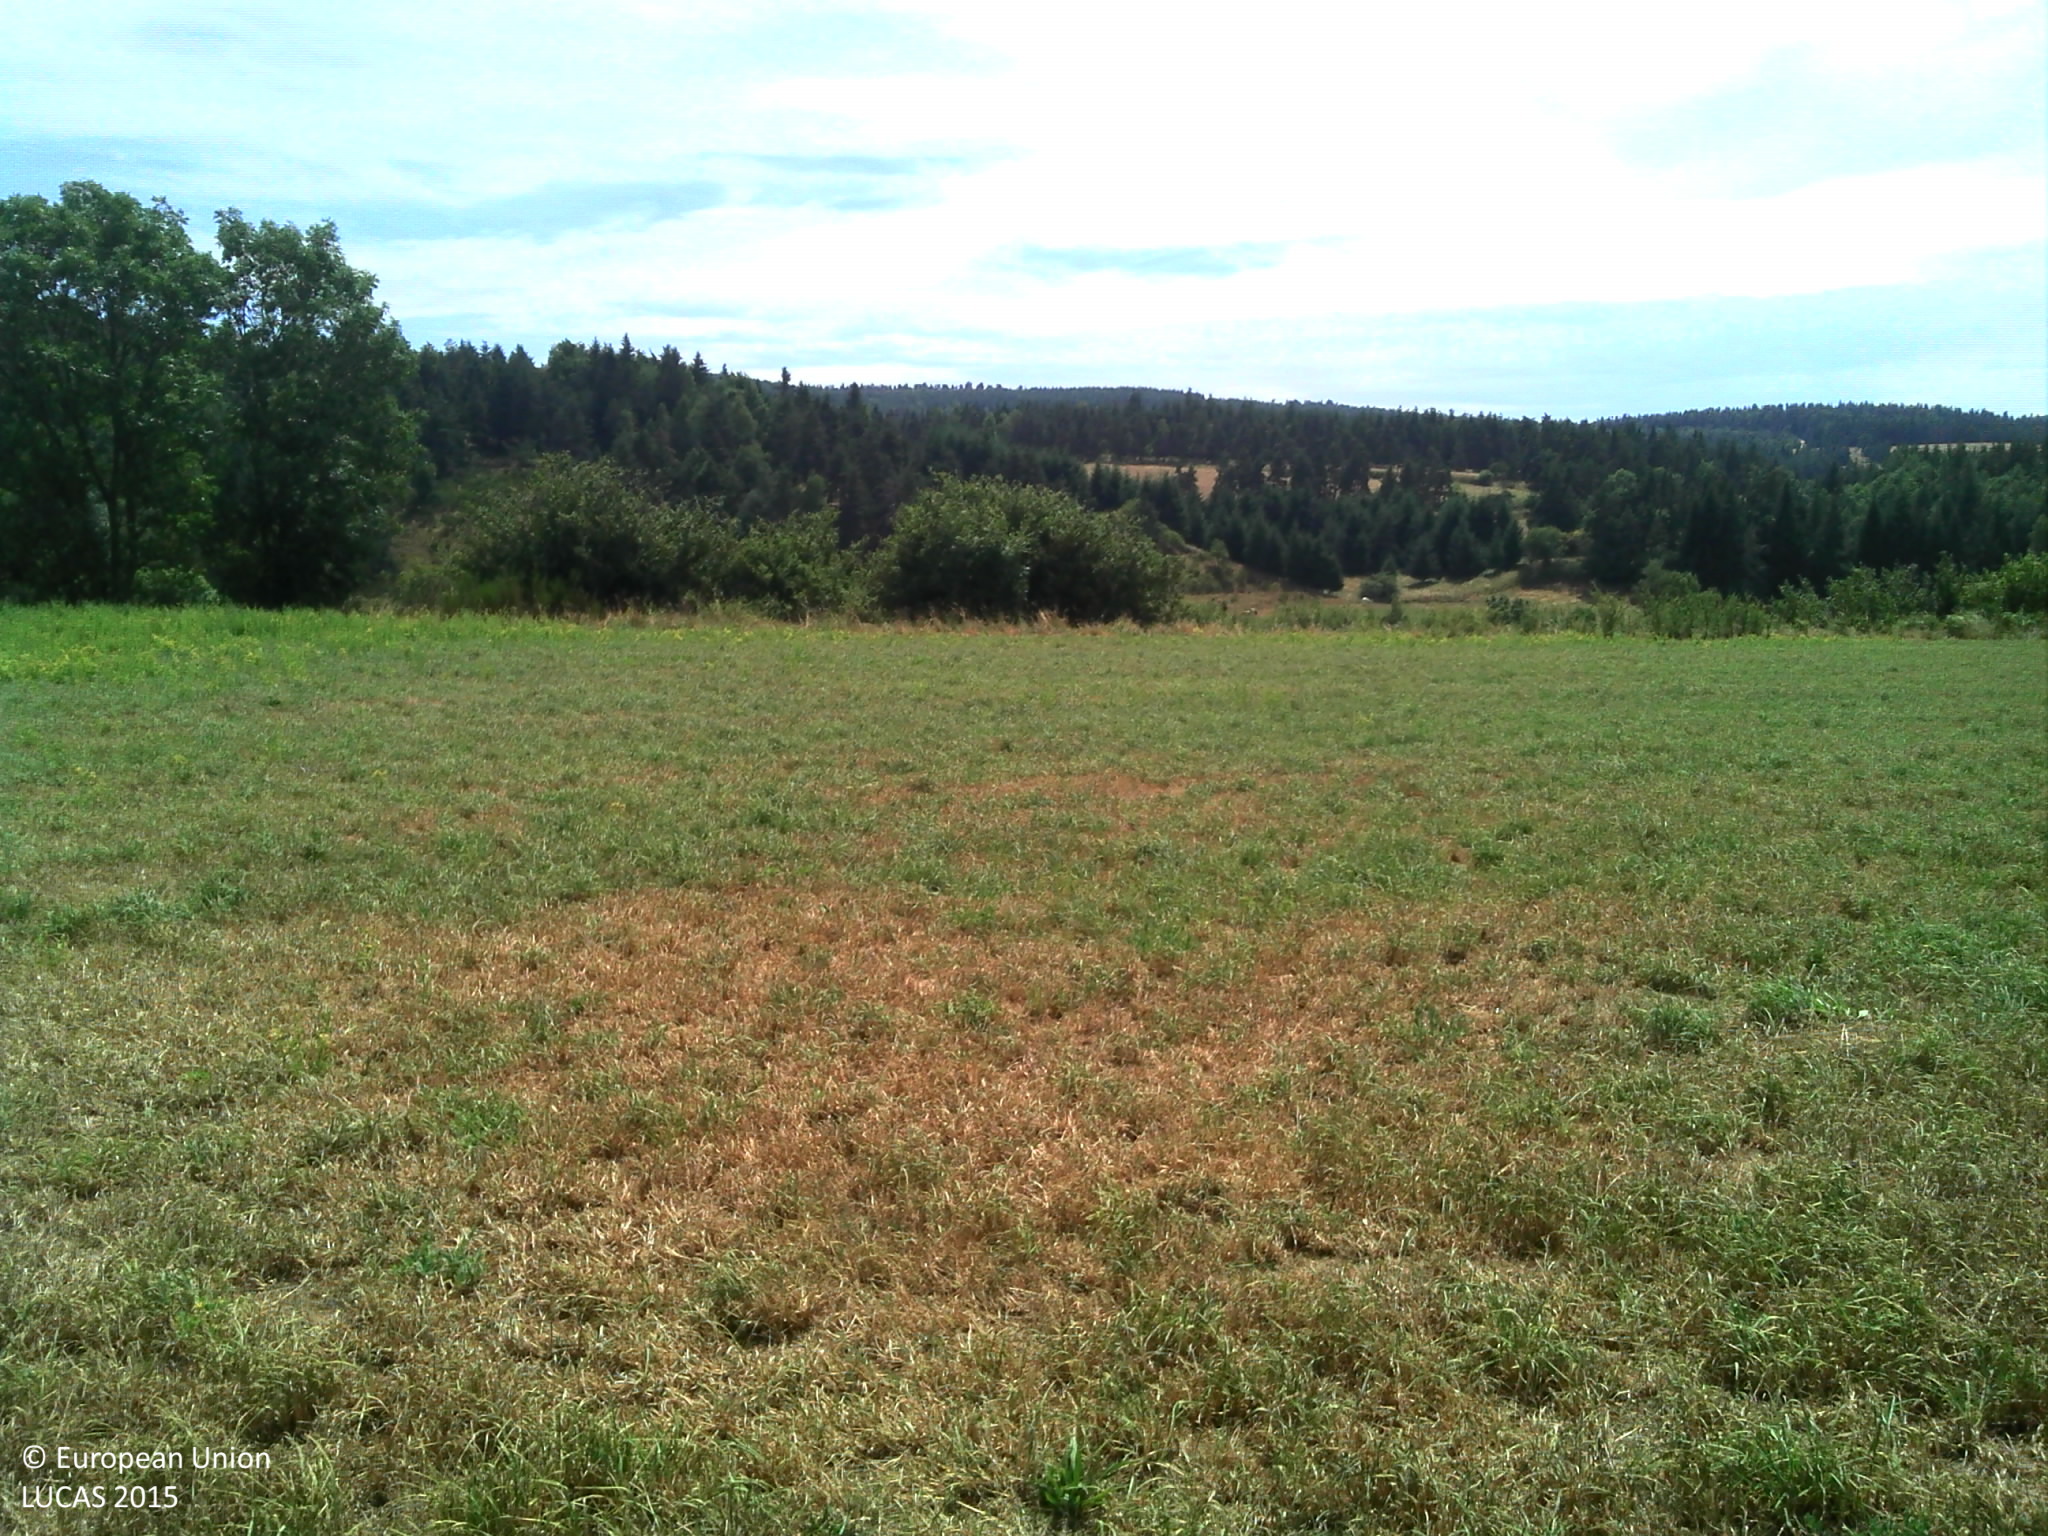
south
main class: Grassland
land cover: Grassland without tree/shrub cover
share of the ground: > 75 %
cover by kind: herbaceous plants 100 %
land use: Agriculture (excluding fallow land and kitchen gardens)
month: July
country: FR
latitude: 44.6780
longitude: 3.9121
